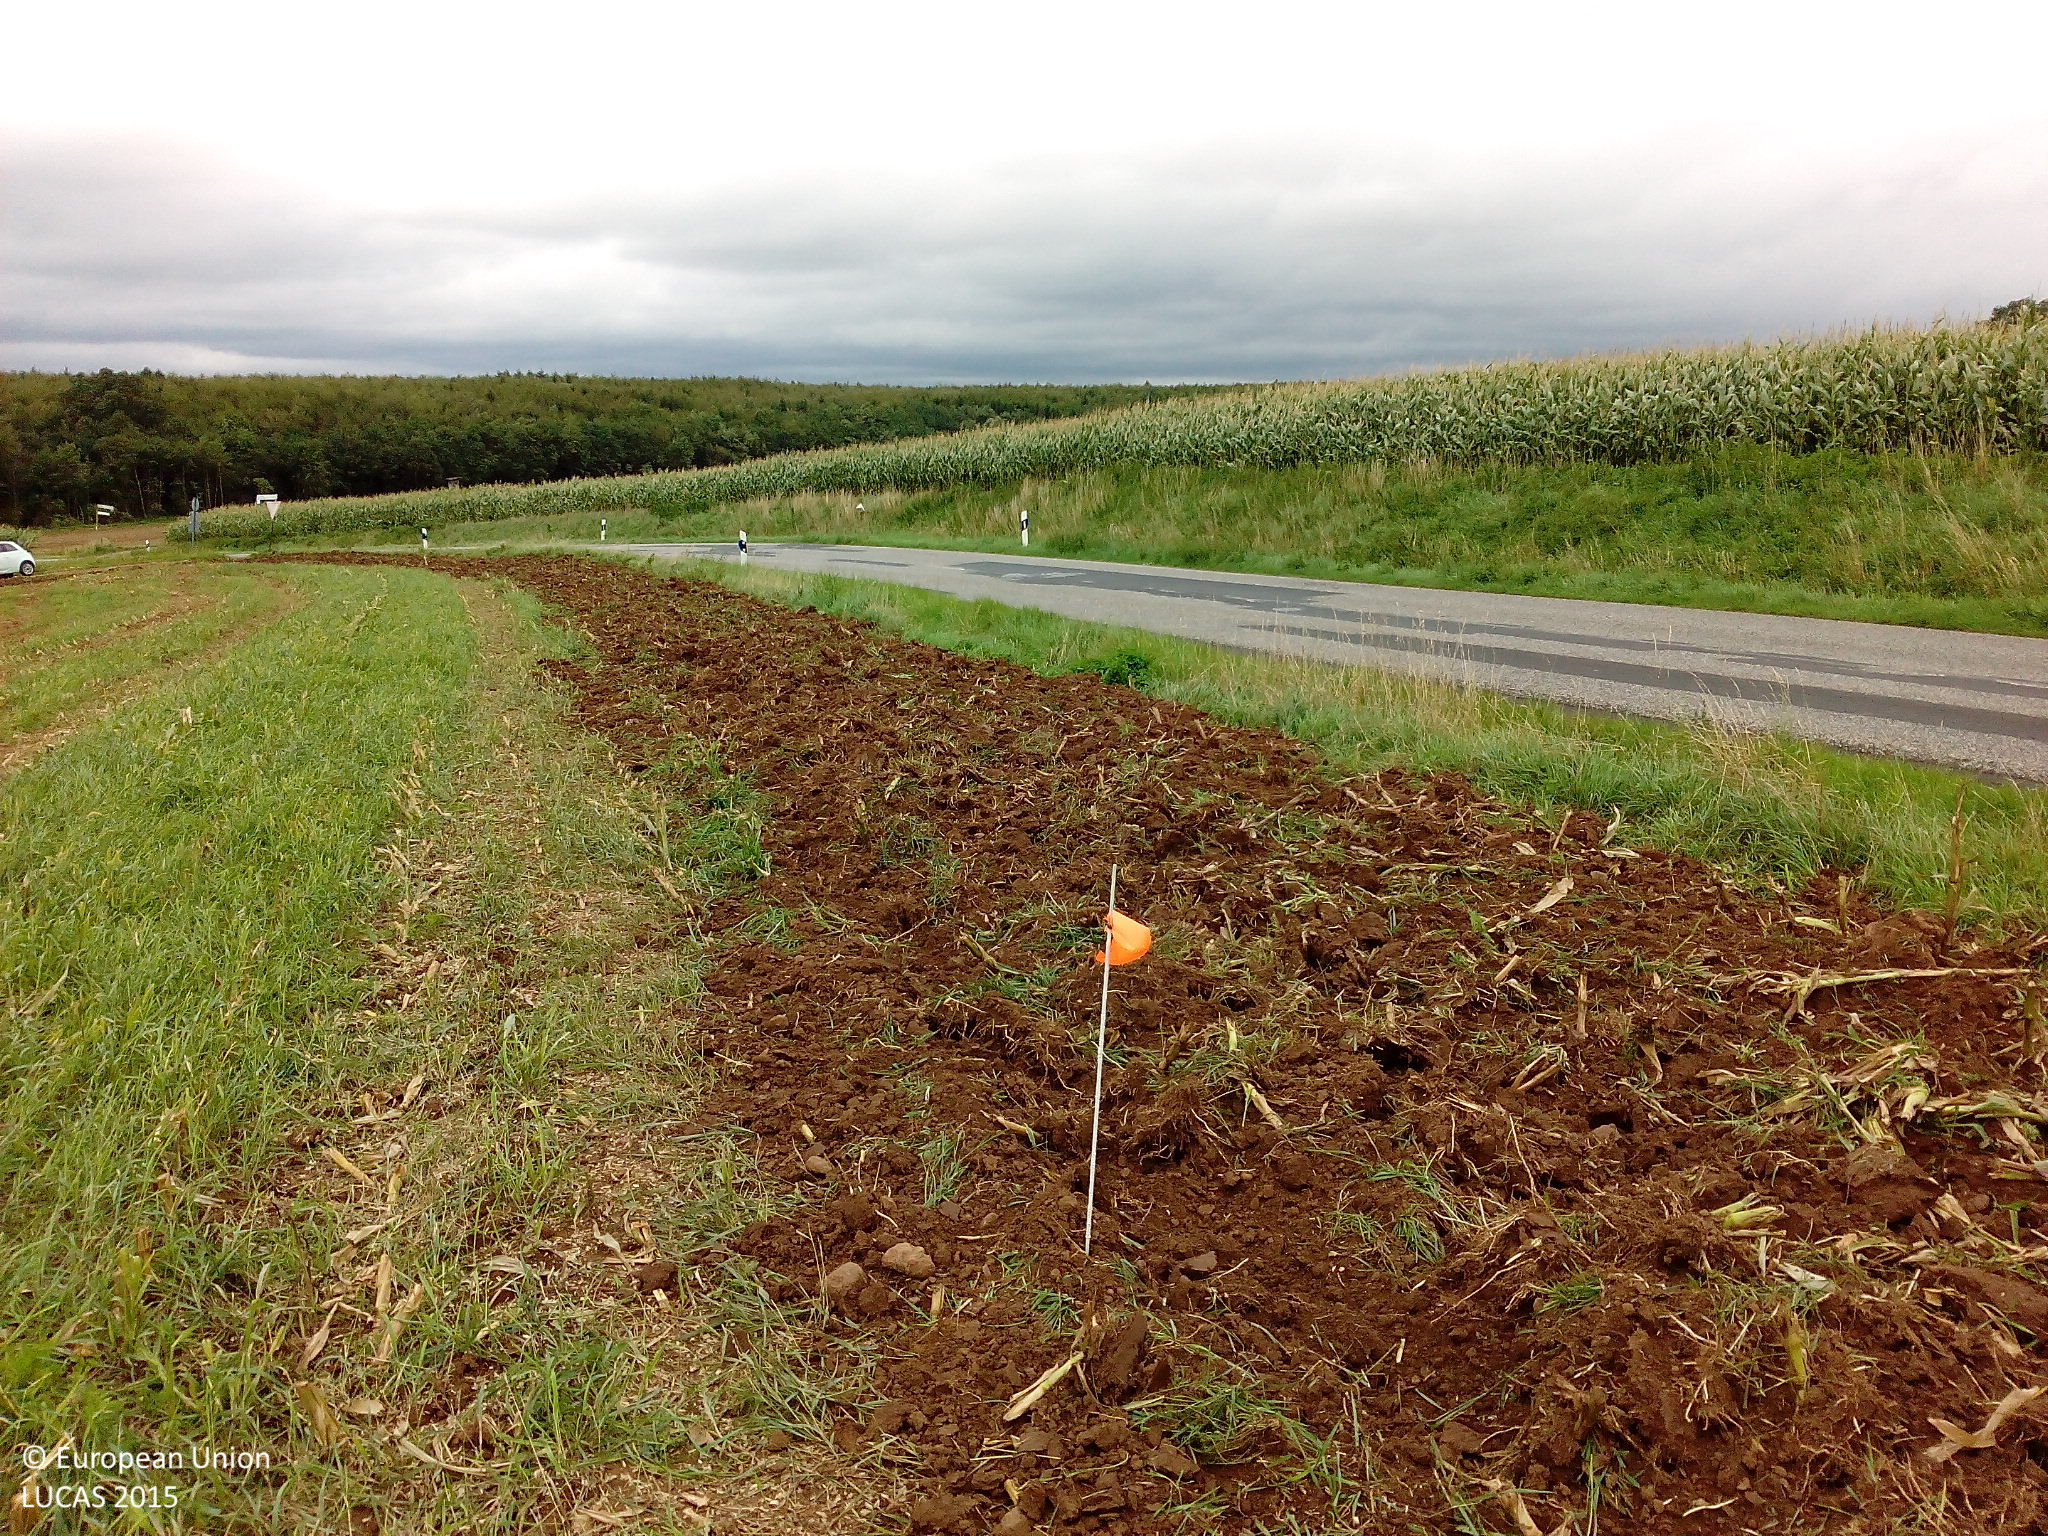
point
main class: Cropland
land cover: Maize
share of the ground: < 10 %
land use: Agriculture (excluding fallow land and kitchen gardens)
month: August
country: DE
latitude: 50.3972
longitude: 9.1984
